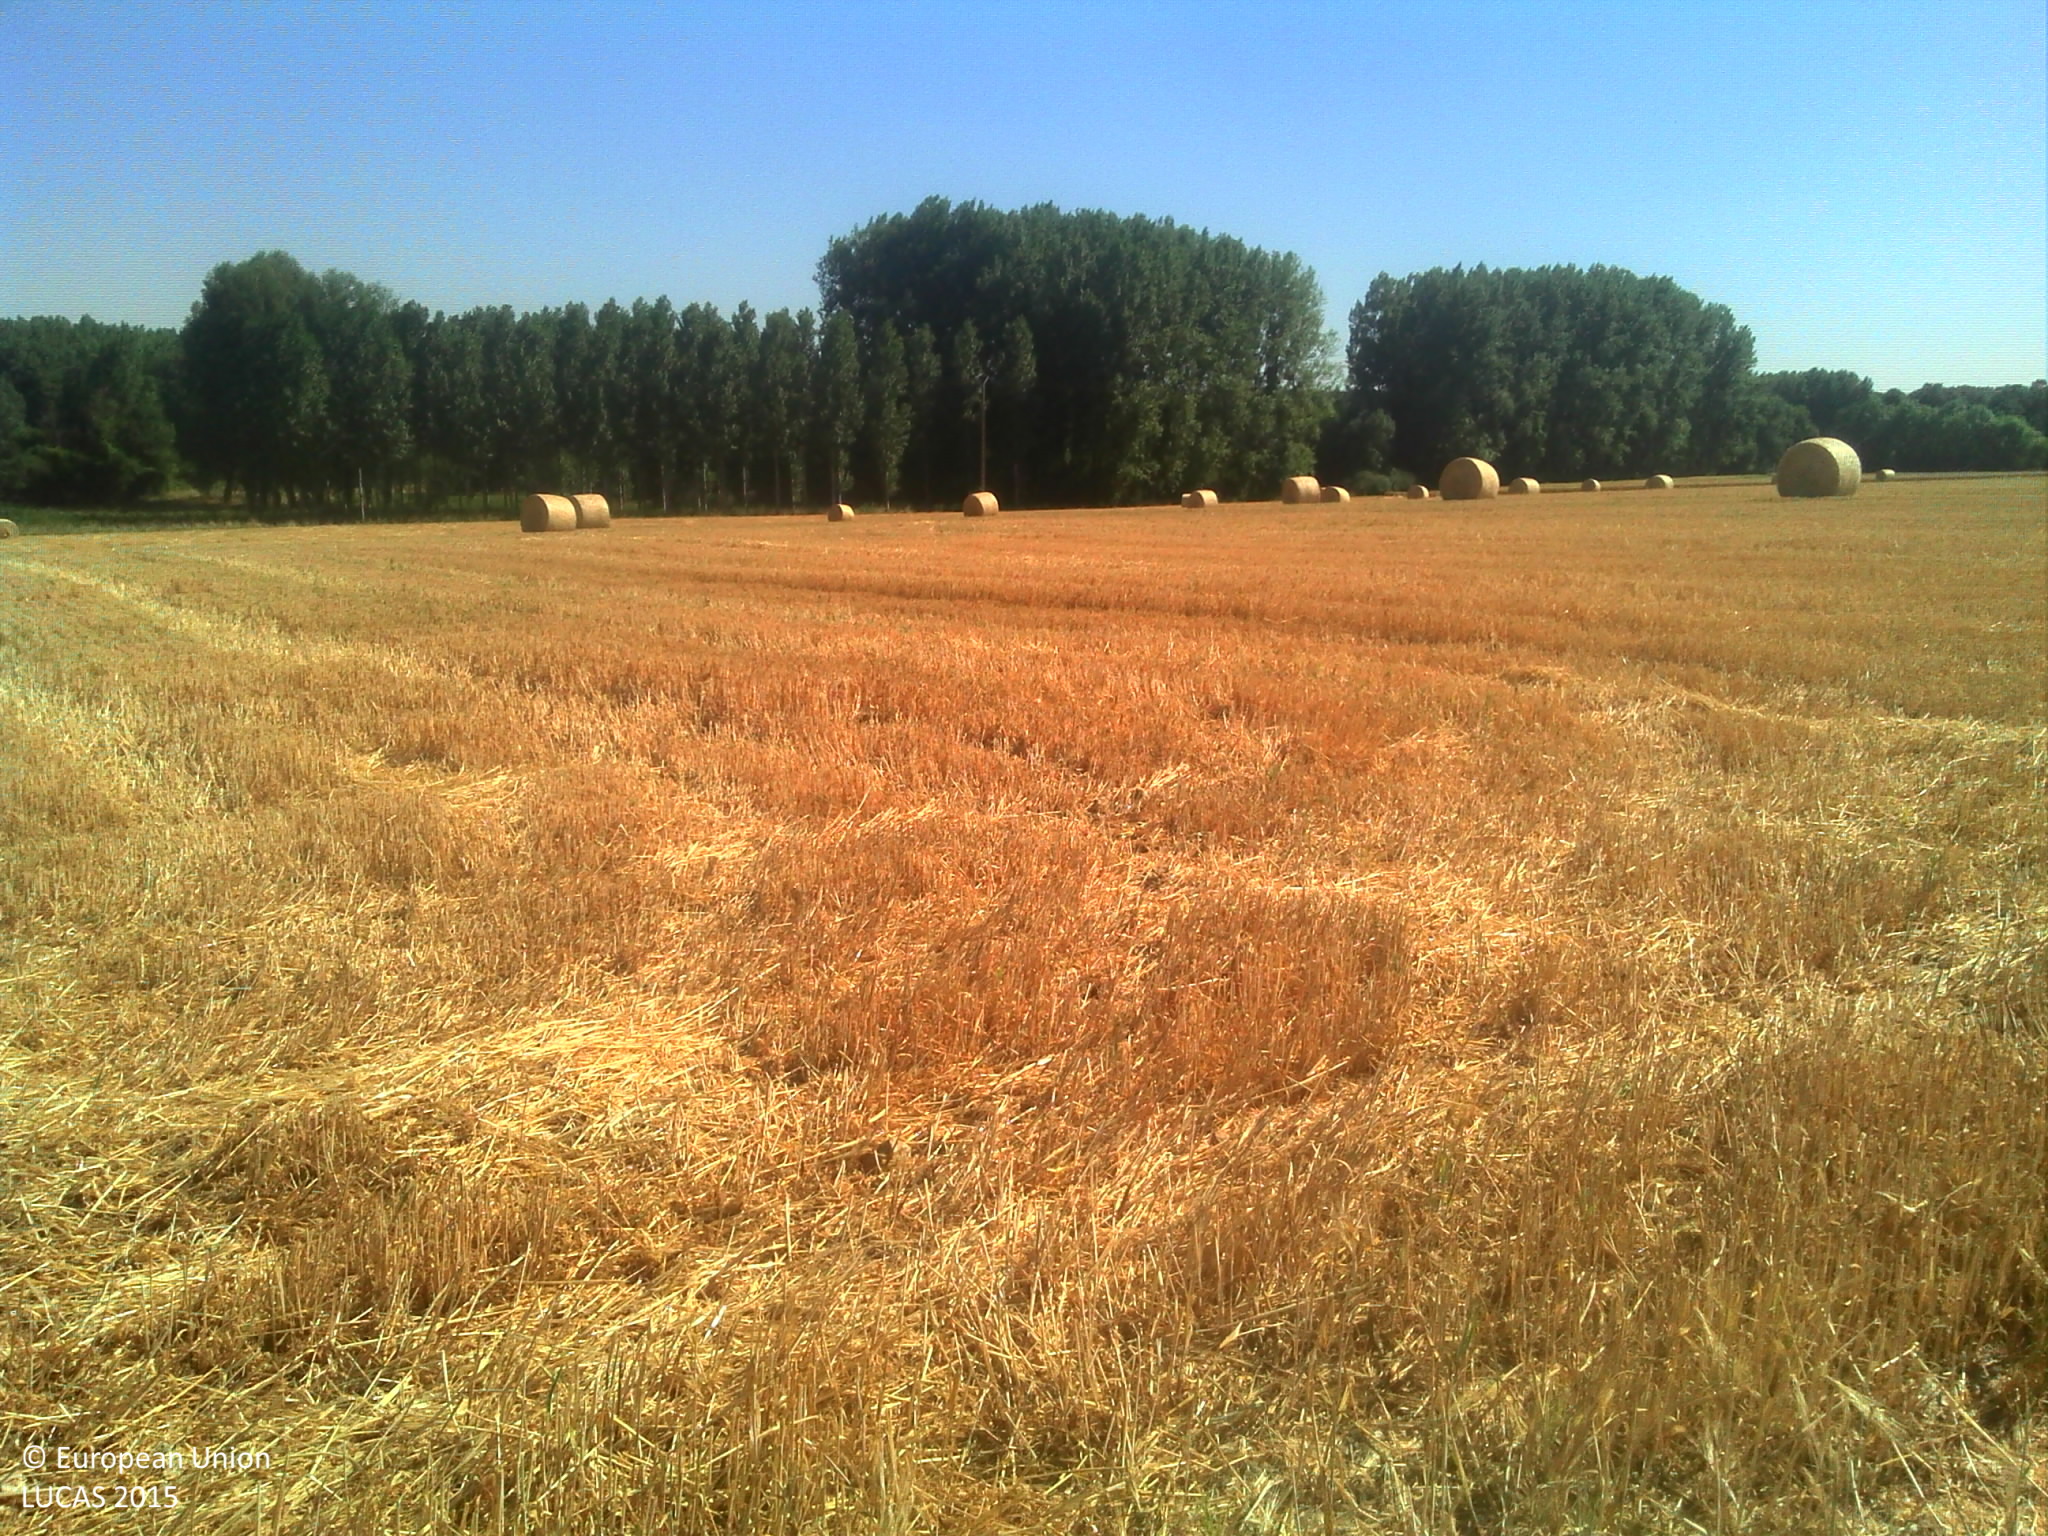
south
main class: Cropland
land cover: Barley
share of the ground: > 75 %
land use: Agriculture (excluding fallow land and kitchen gardens)
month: June
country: FR
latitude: 47.3300
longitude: 1.4513
